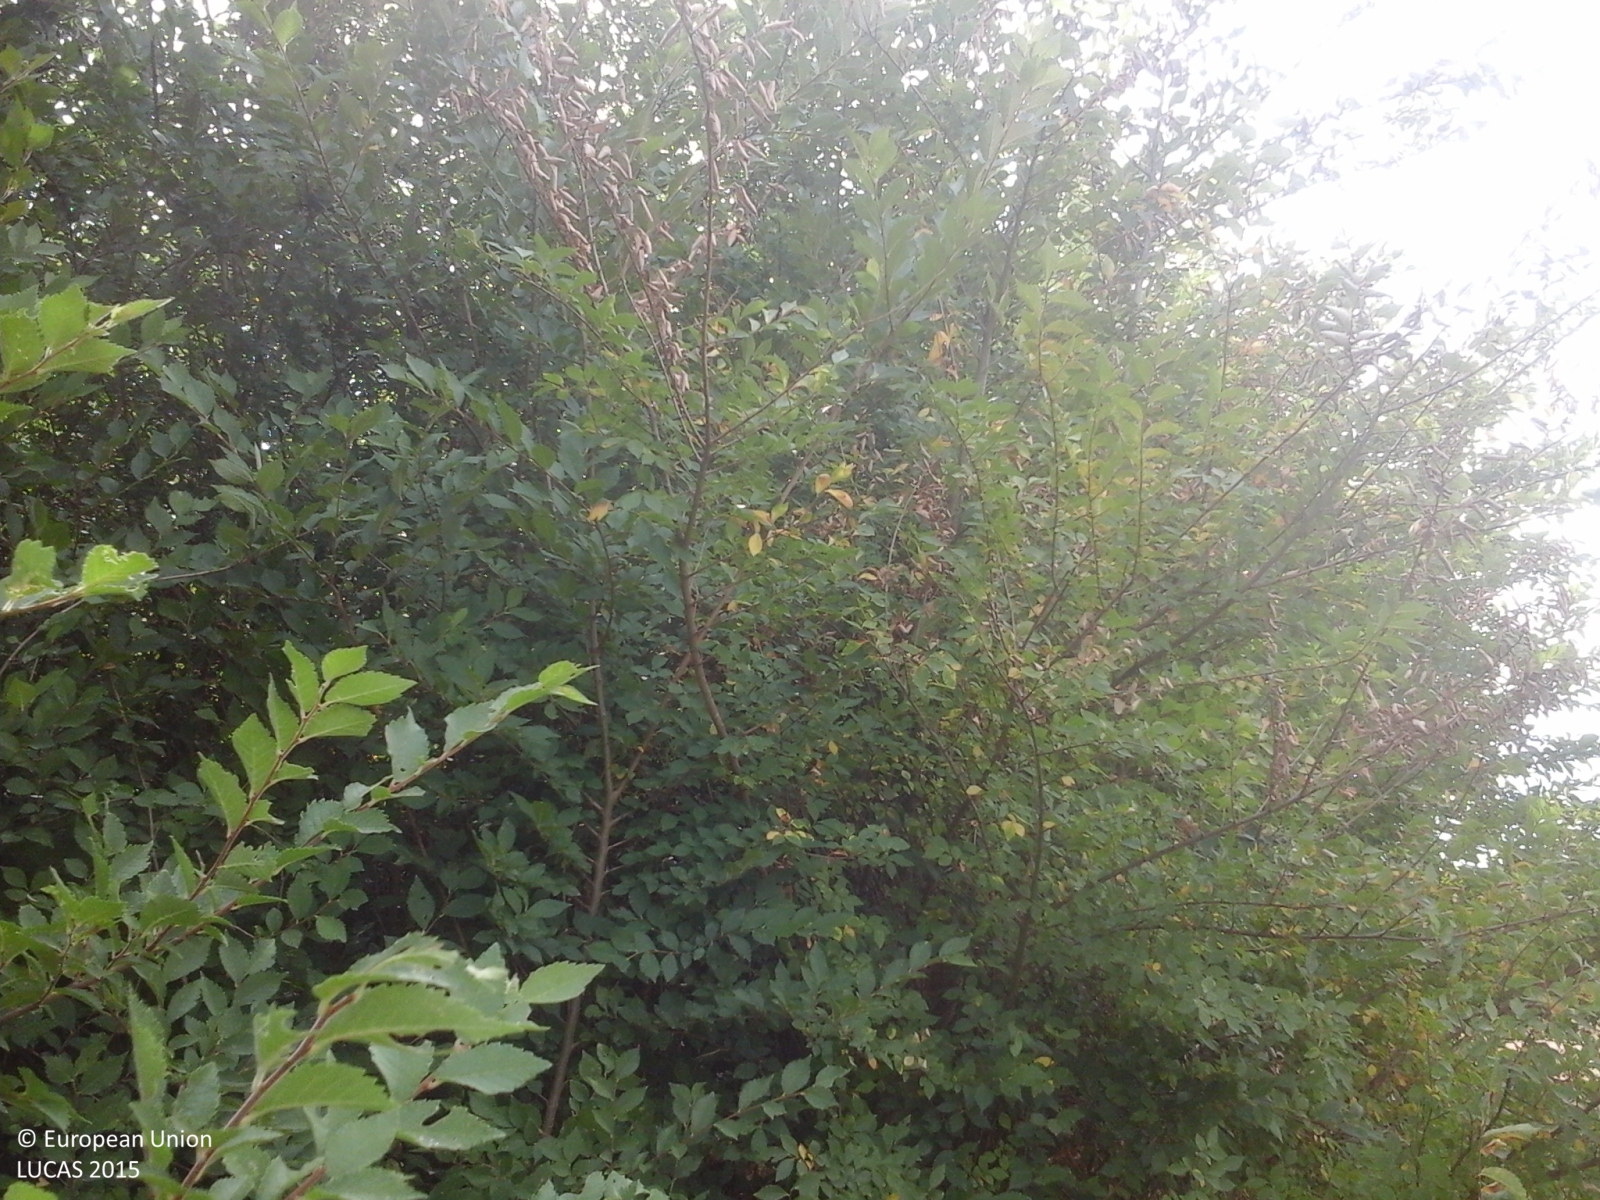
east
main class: Woodland
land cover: Broadleaved woodland
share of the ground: > 75 %
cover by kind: broadleaved forest trees 90 %, shrubs 10 %
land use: Abandoned areas
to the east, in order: Broadleaved woodland; Grassland without tree/shrub cover; Abandoned hedges; Olive groves; Rock outcrops; Grassland with sparse tree/shrub cover; Spontaneously vegetated surfaces; Lines of trees; Ditches and canals; Lines of trees; Spontaneously vegetated surfaces; Single bushes/trees; Spontaneously vegetated surfaces; Lines of trees; Tracks; Broadleaved woodland; Durum wheat; Dry pulses
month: June
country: IT
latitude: 41.0213
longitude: 15.1300
